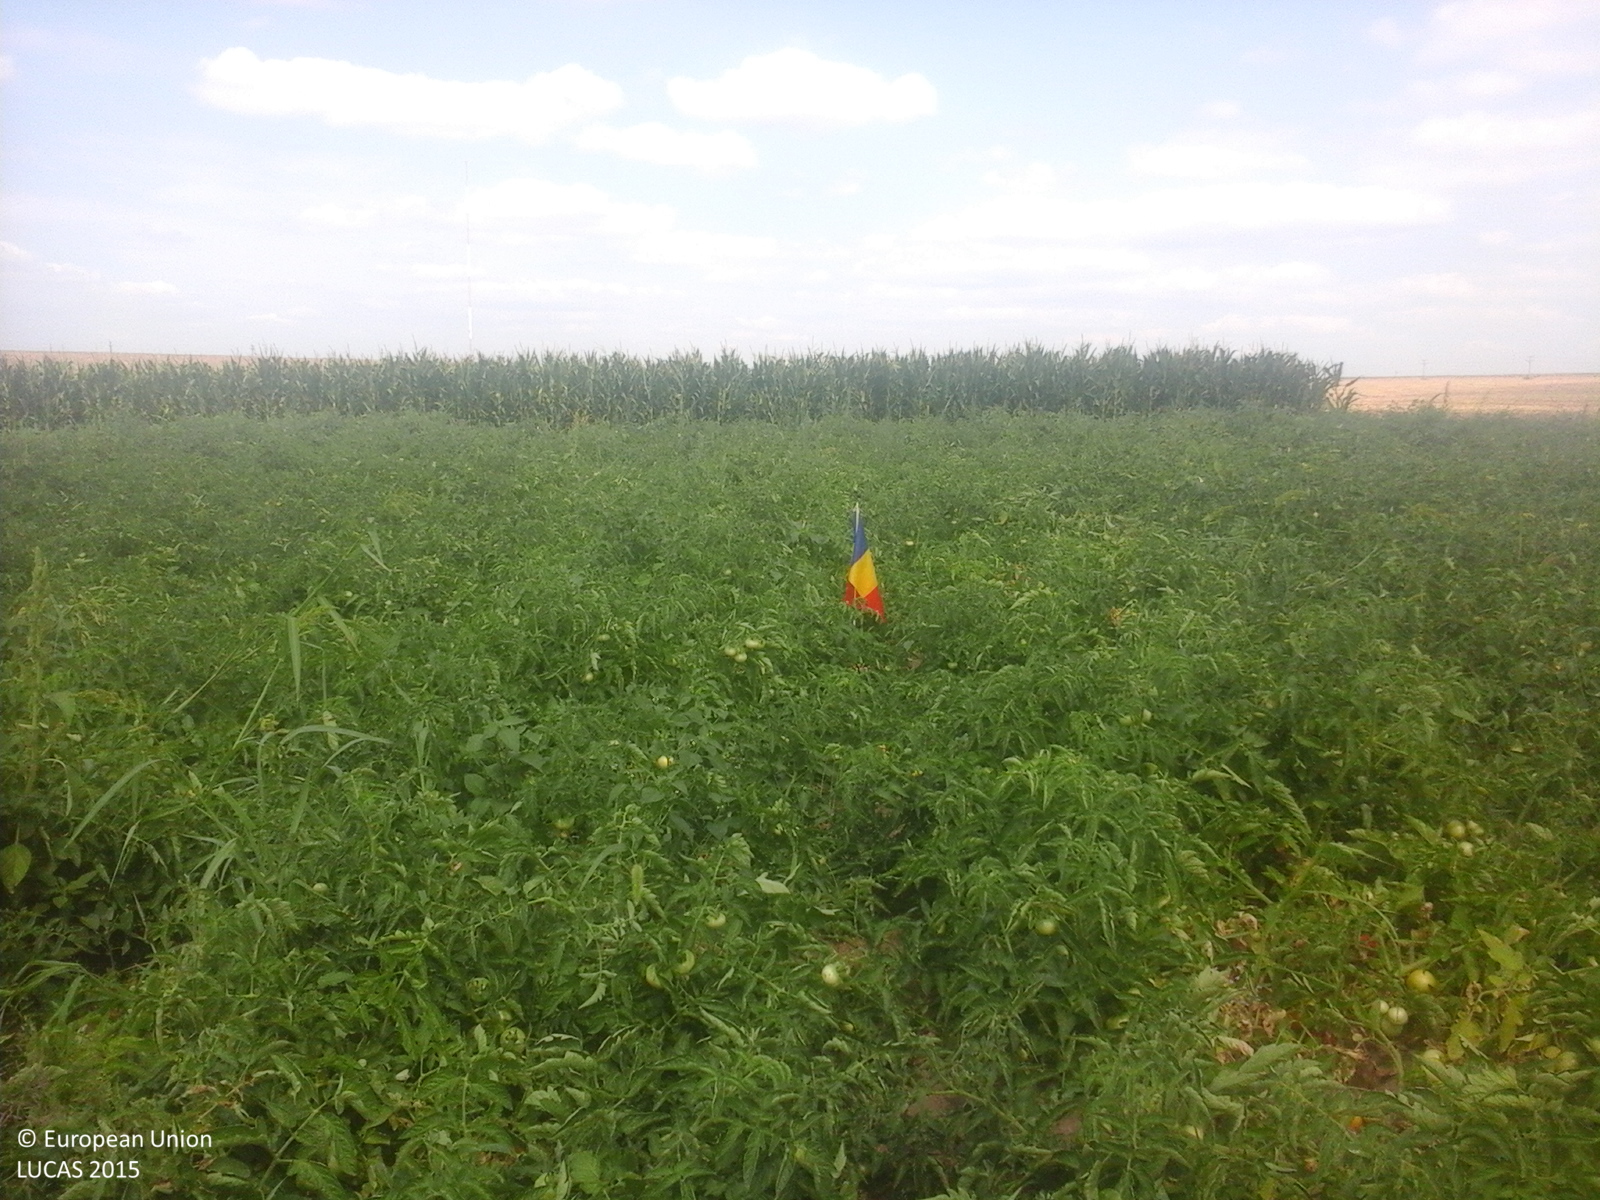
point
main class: Cropland
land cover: Tomatoes
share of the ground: > 75 %
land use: Agriculture (excluding fallow land and kitchen gardens)
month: August
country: RO
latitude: 44.6681
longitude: 28.2683
